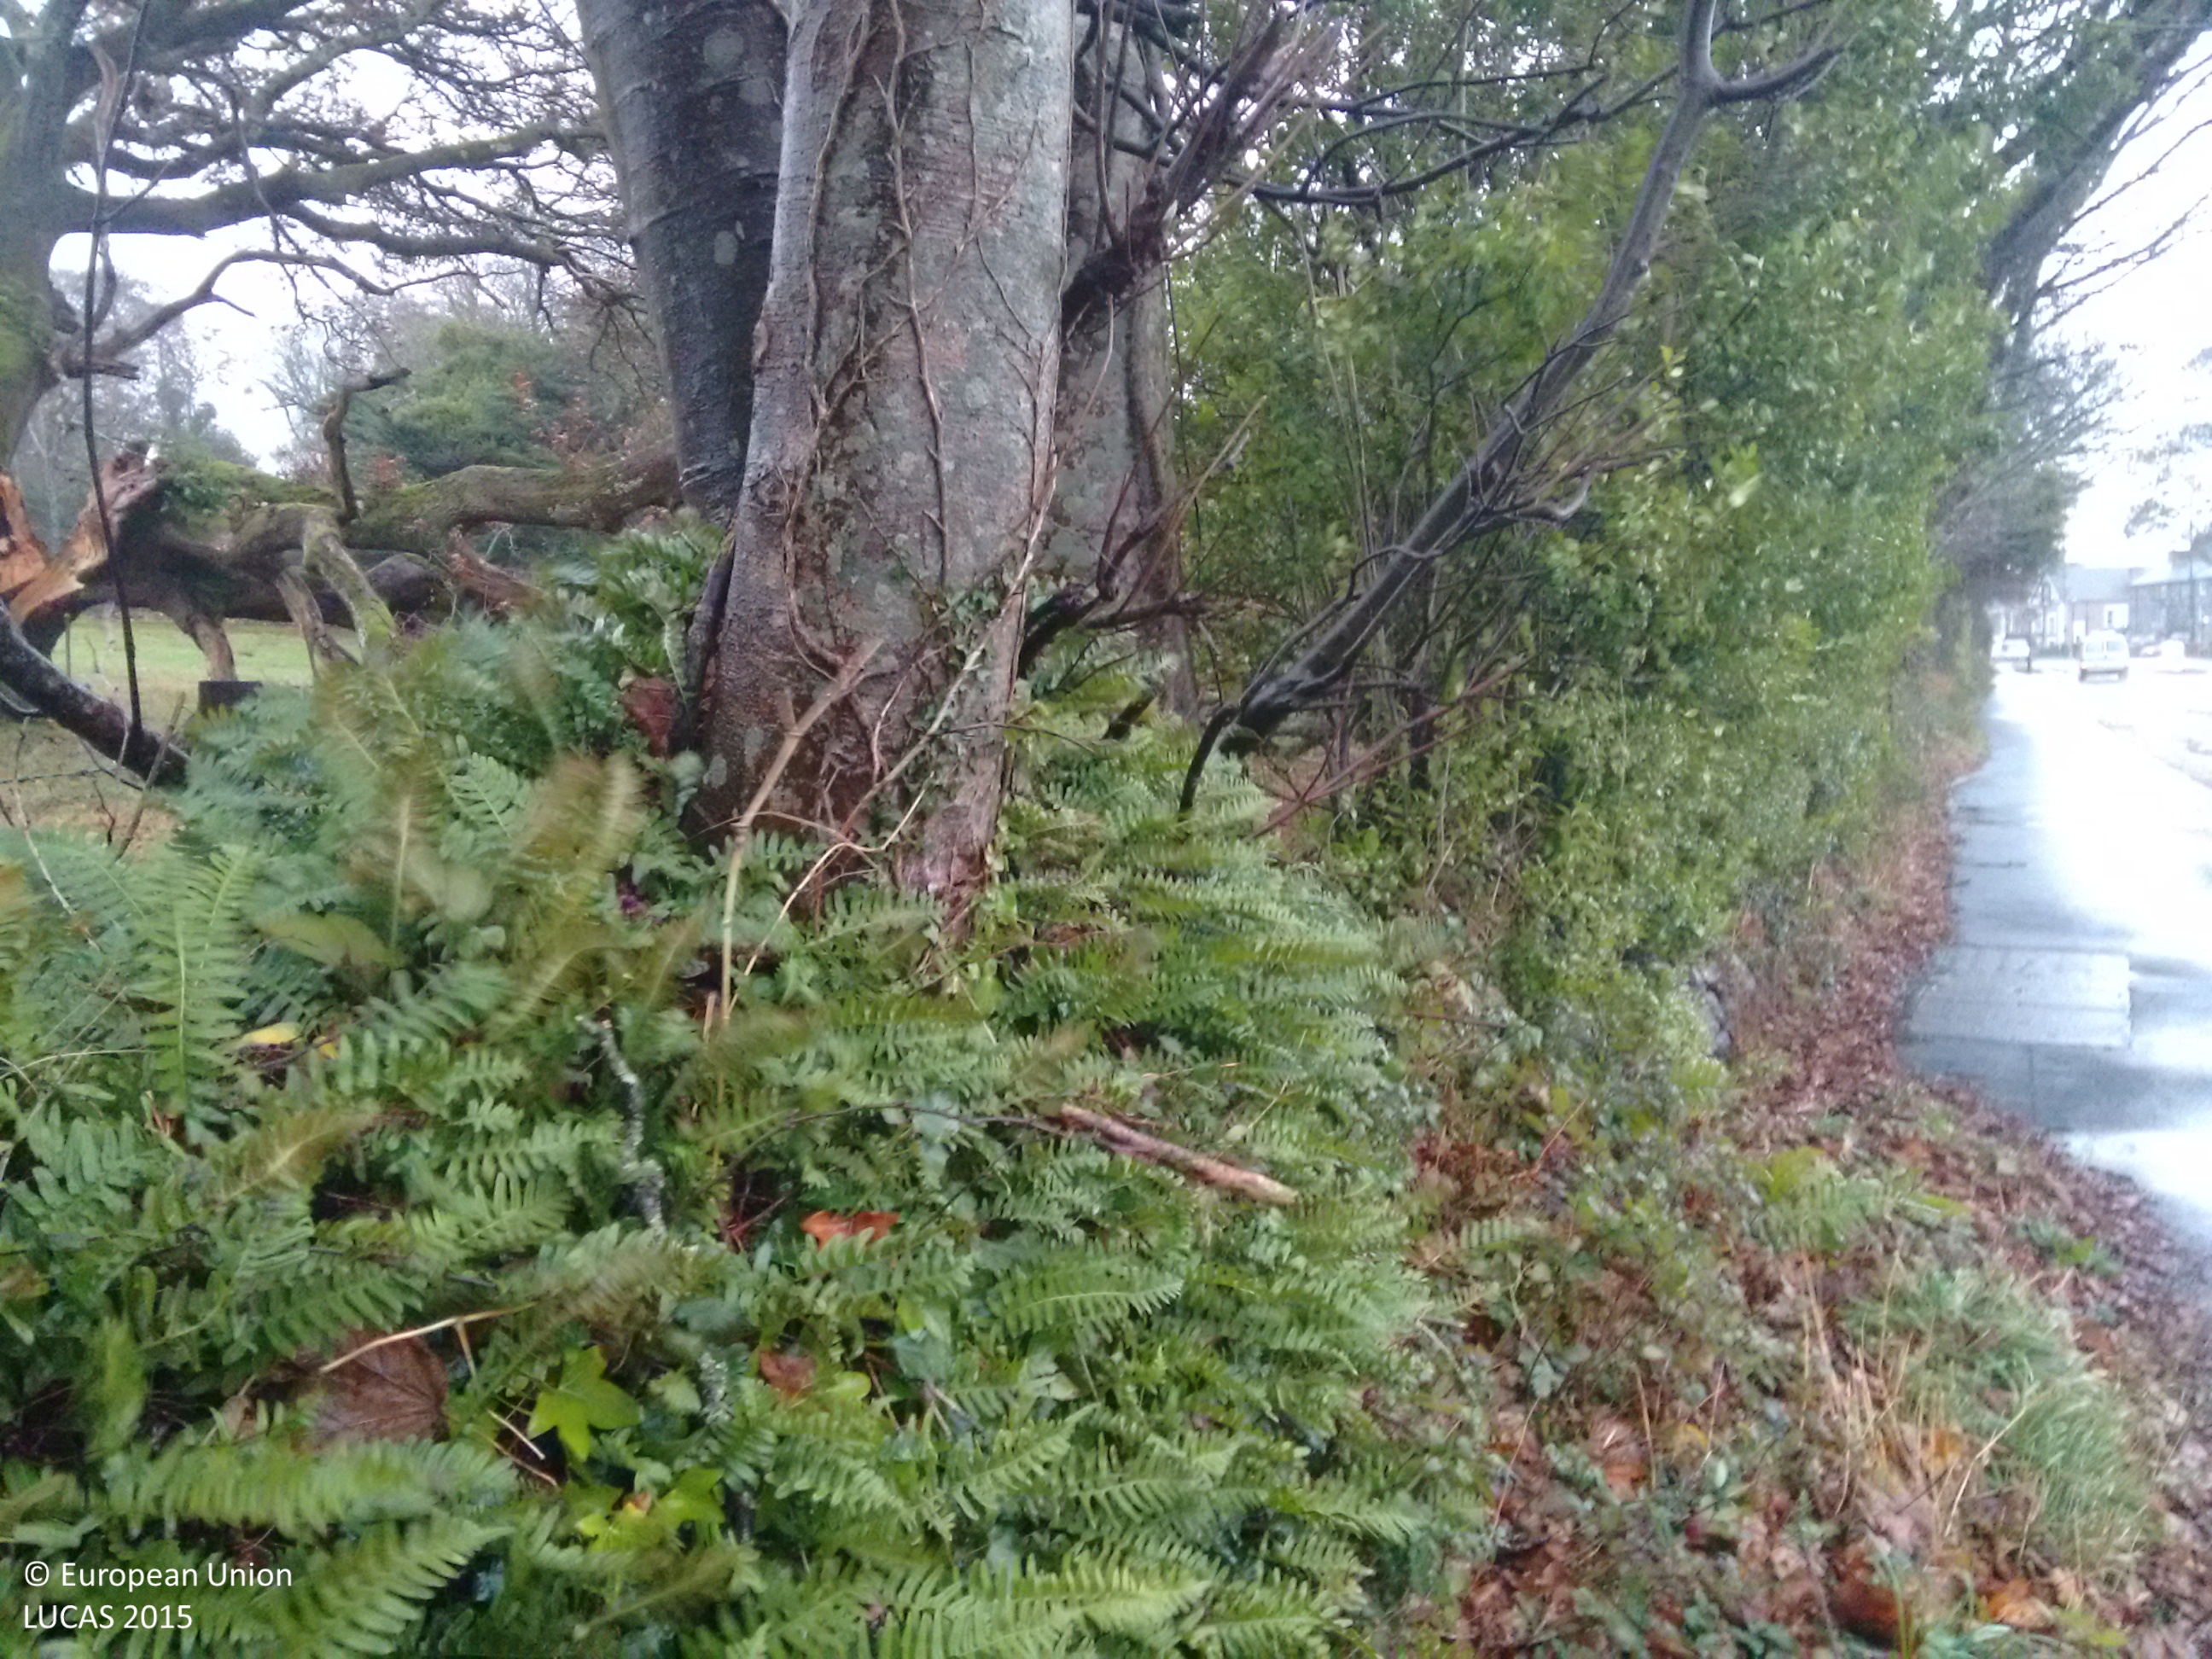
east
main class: Grassland
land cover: Grassland with sparse tree/shrub cover
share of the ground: > 75 %
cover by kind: herbaceous plants 95 %, broadleaved forest trees 5 %
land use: Amenities, museums, leisure
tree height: > 5 m
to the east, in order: Grassland with sparse tree/shrub cover; Fences; Tracks; Grassland with sparse tree/shrub cover; Fences; Grassland with sparse tree/shrub cover; Artificial constructions; Paved roads, cycling and walking lanes; Artificial constructions; Managed hedges; Grassland without tree/shrub cover; Single bushes/trees; Fences; Managed hedges; Artificial constructions in urban areas
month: November
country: GB
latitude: 52.9195
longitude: -4.2437
